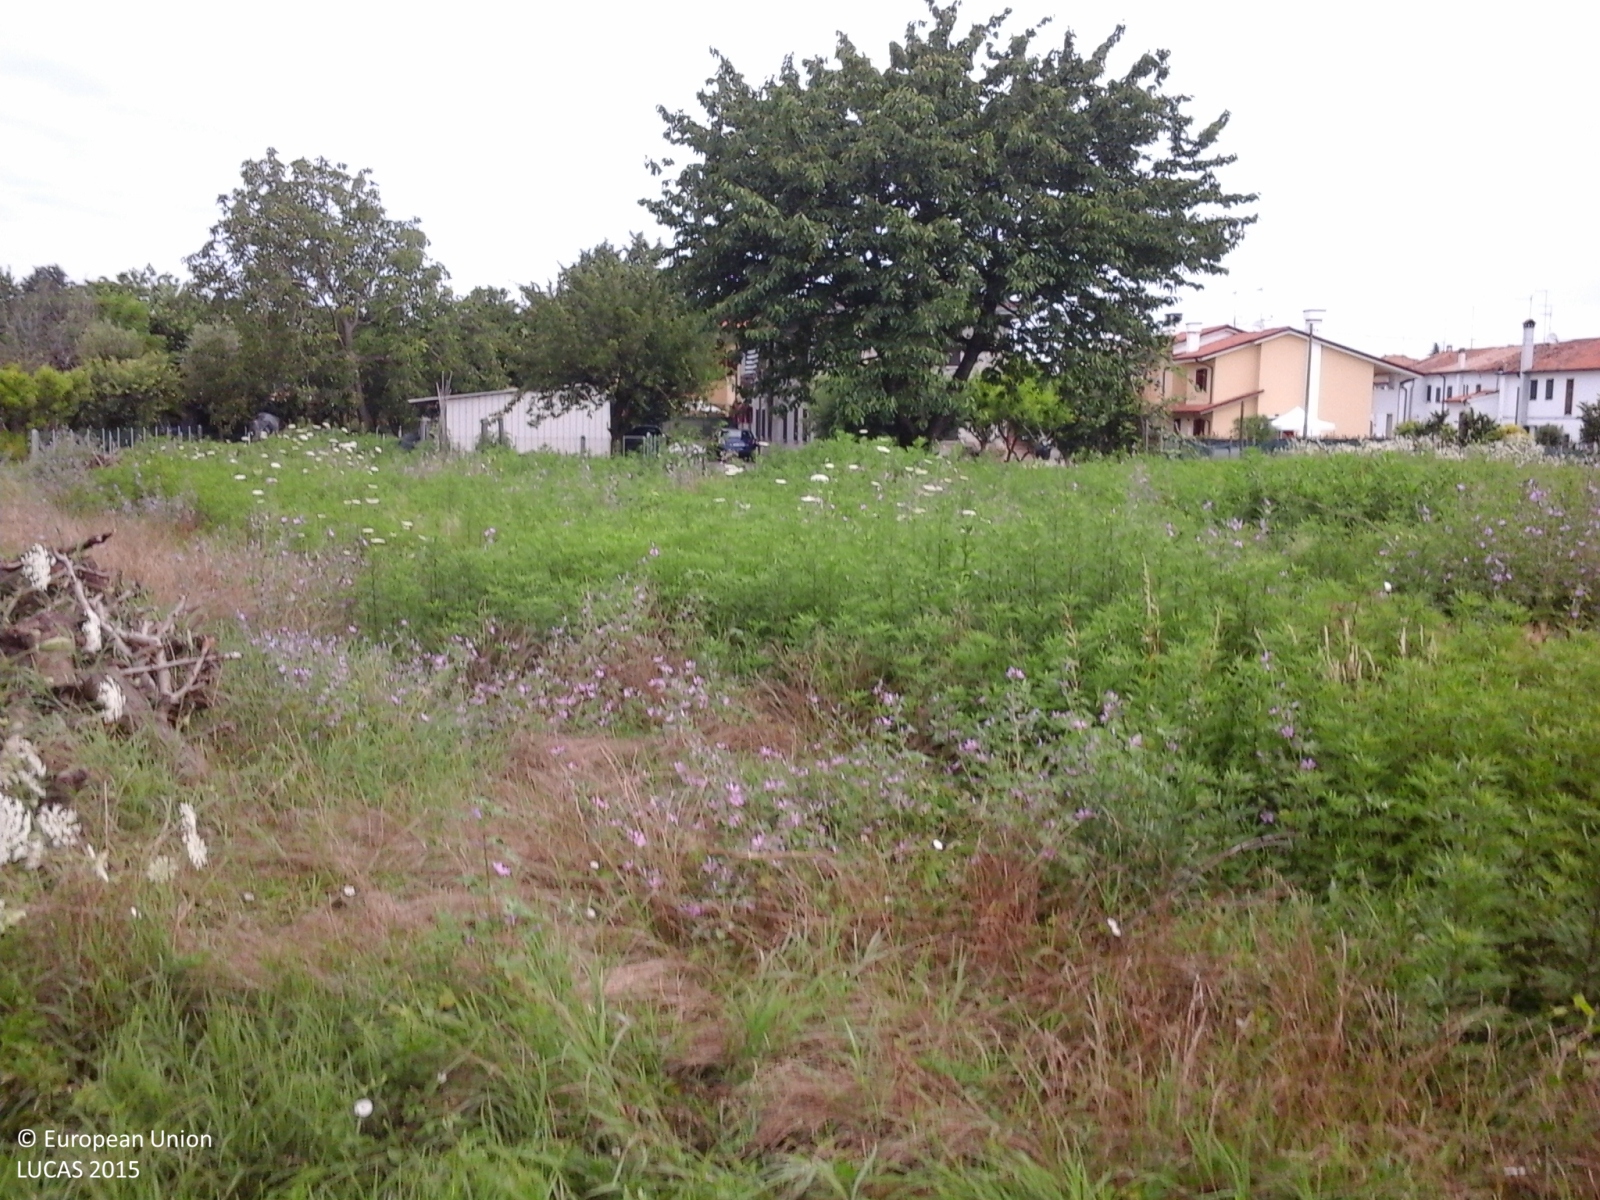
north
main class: Grassland
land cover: Spontaneously vegetated surfaces
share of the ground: > 75 %
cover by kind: herbaceous plants 100 %
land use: Fallow land
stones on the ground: < 10 %
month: June
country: IT
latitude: 45.6731
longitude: 12.4997
